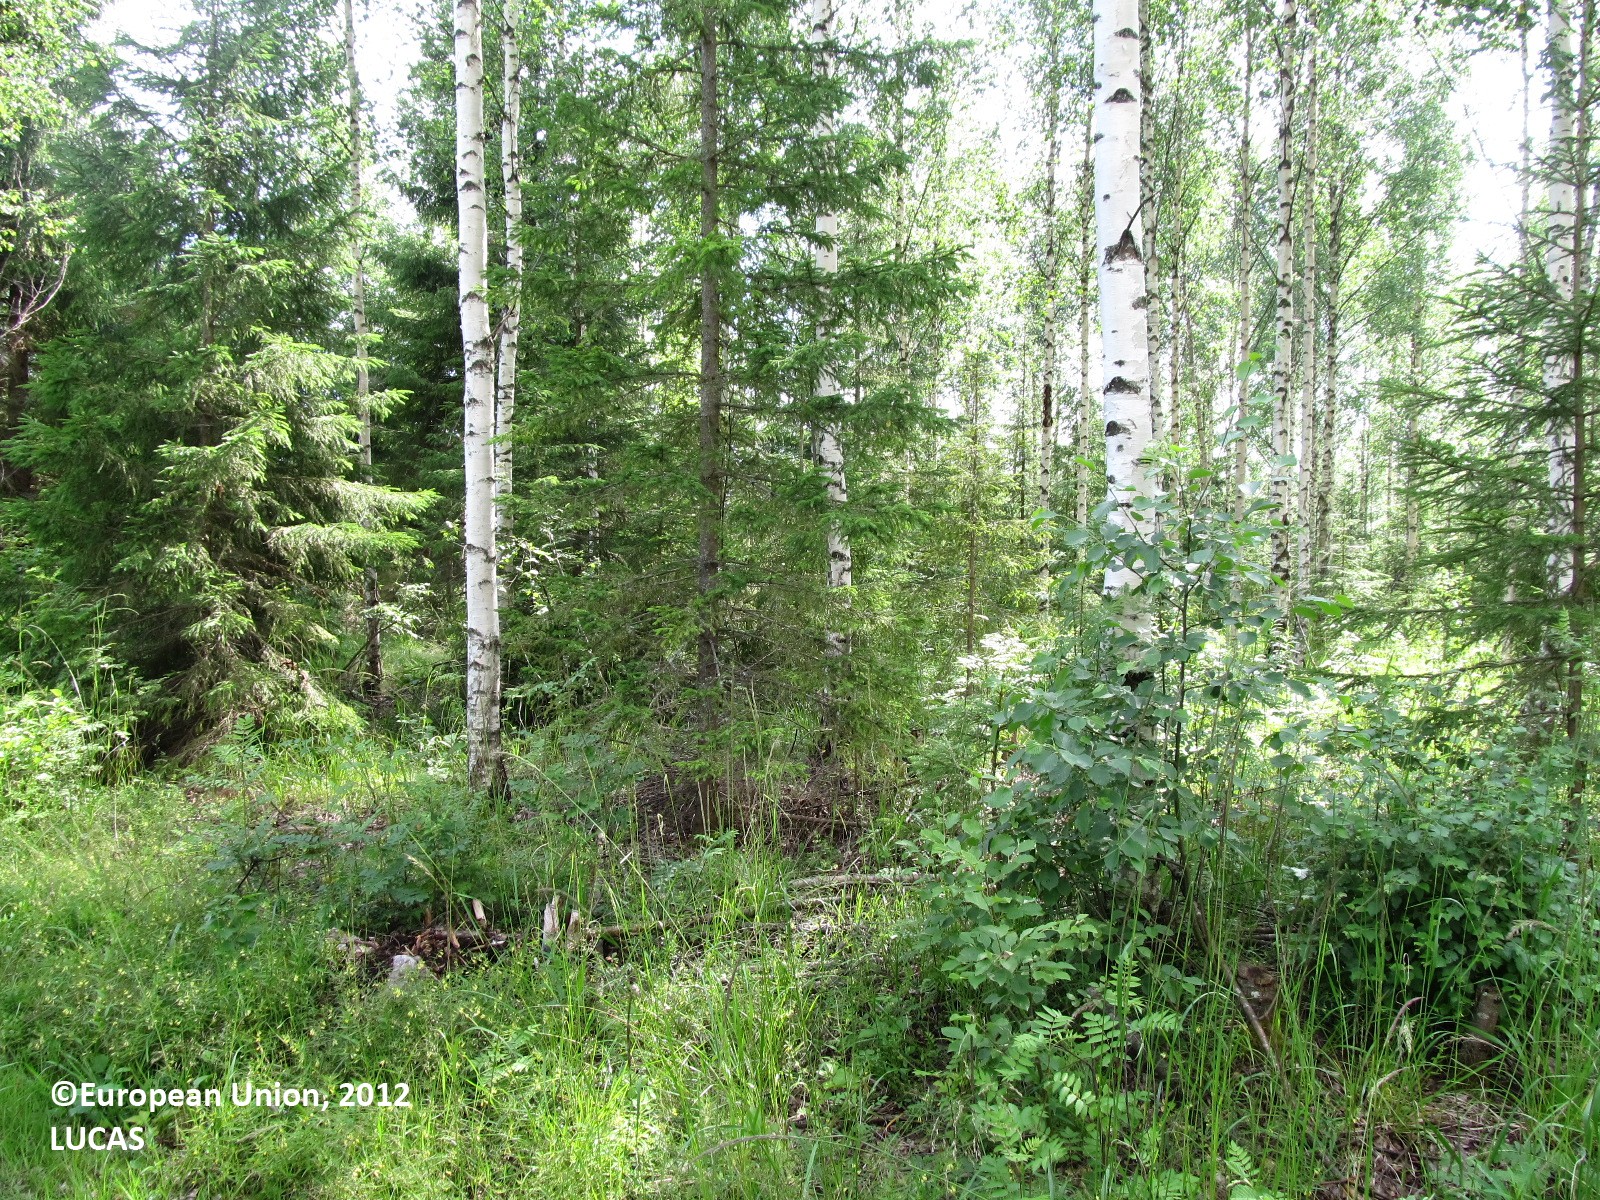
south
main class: Woodland
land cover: Spruce dominated mixed woodland
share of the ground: 25 - 50 %
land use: Forestry
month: July
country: FI
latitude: 61.9323
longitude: 28.3585
